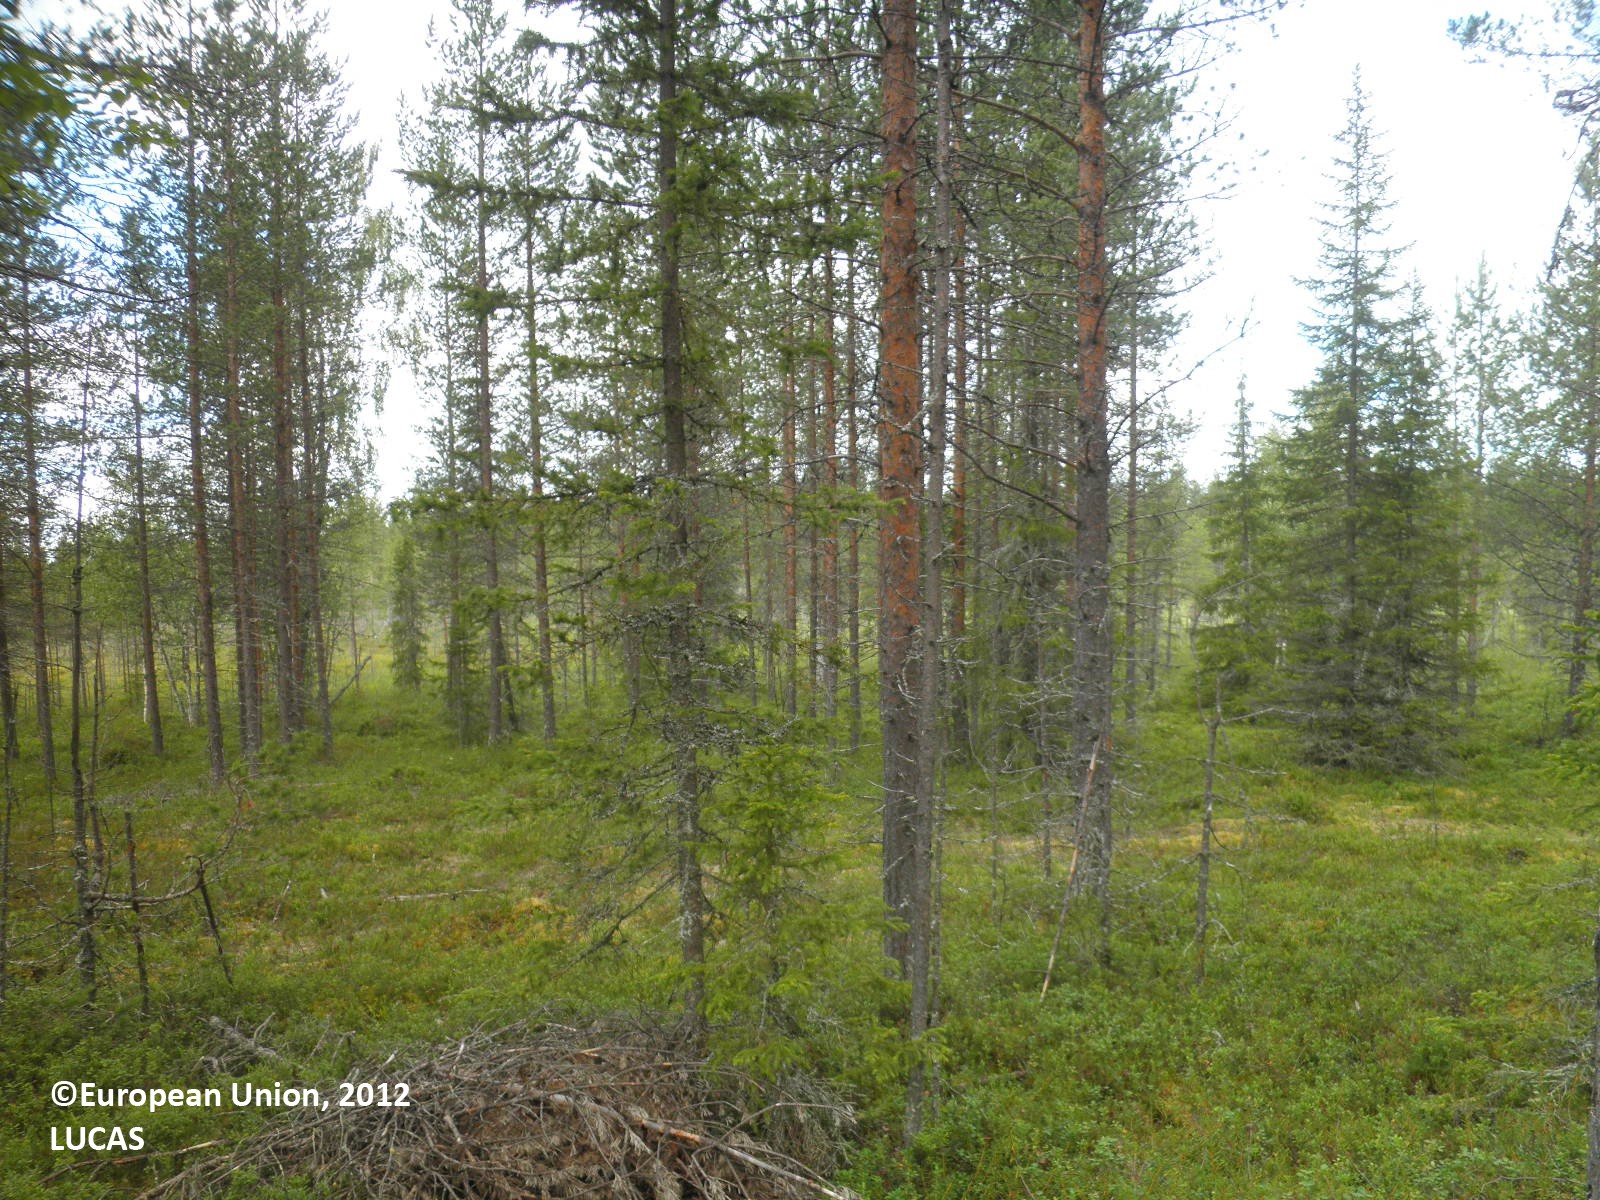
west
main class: Woodland
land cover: Pine dominated coniferous woodland
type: boreal forest
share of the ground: 50 - 75 %
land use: Forestry
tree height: > 5 m
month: August
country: FI
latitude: 67.0761
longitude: 28.9955
